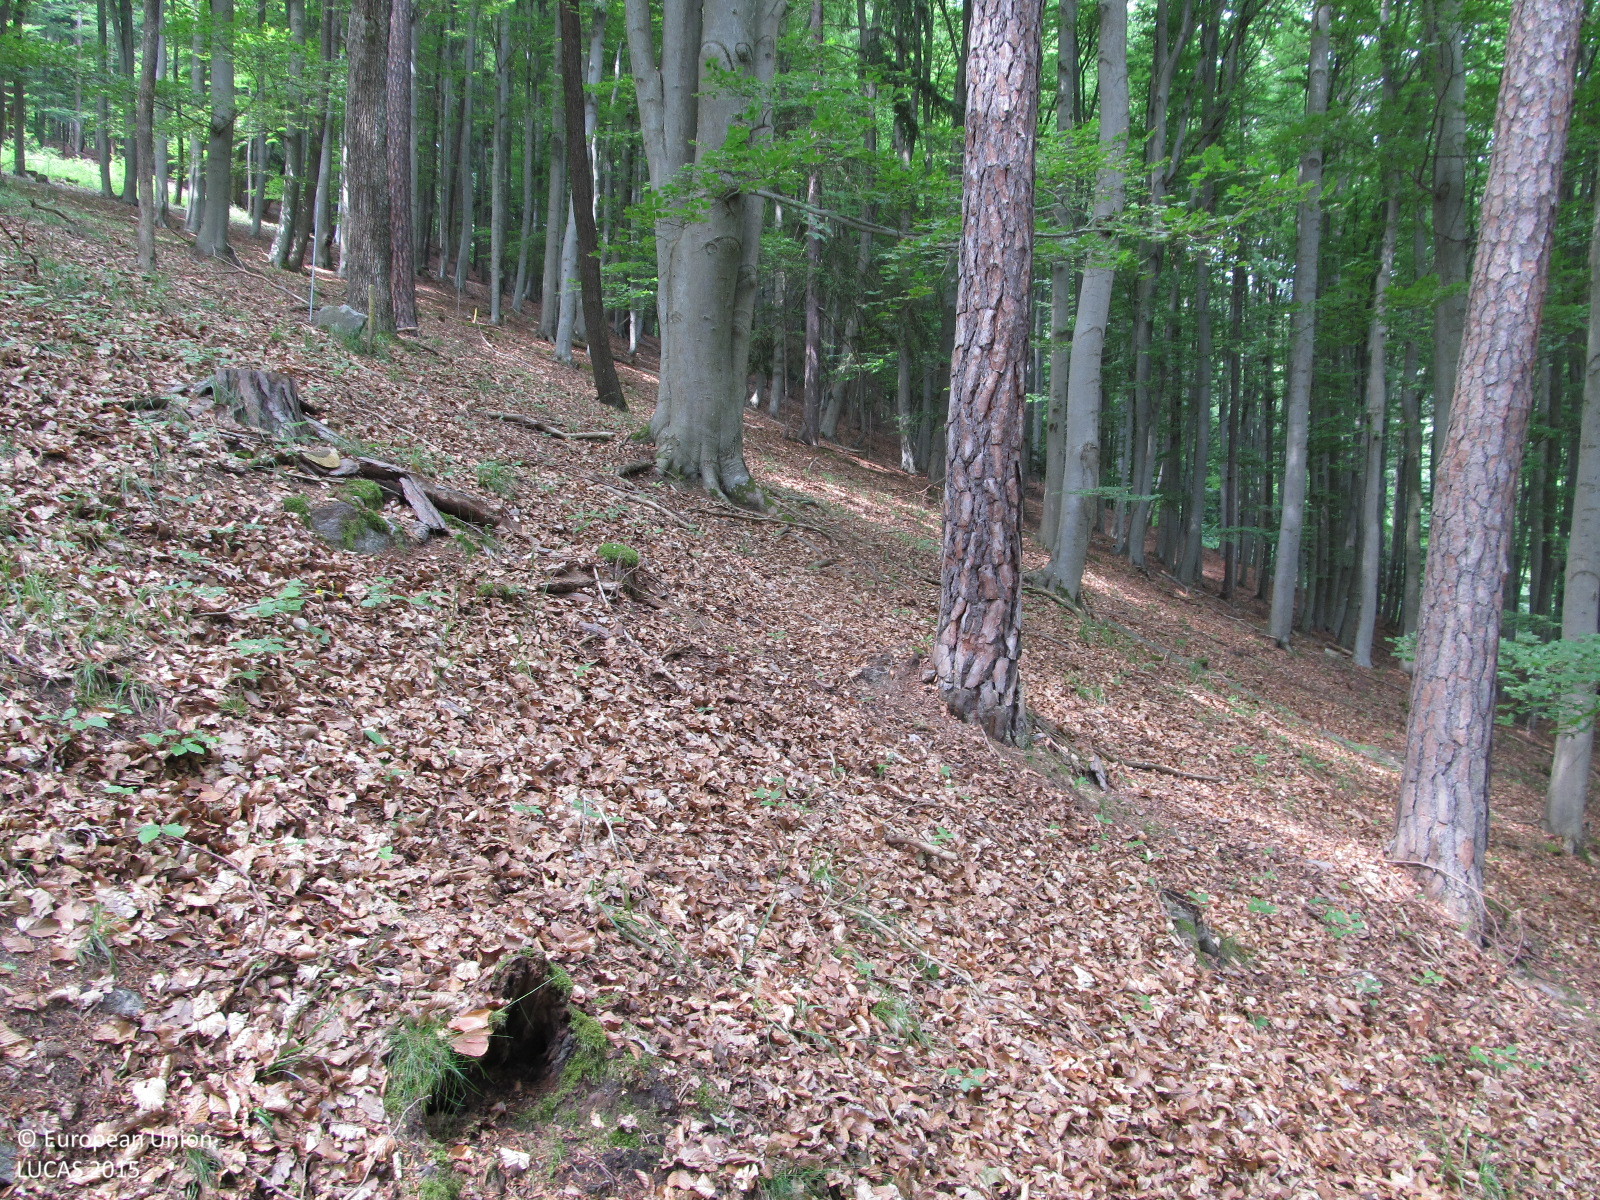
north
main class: Woodland
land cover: Broadleaved woodland
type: beech forest
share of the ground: > 75 %
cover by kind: broadleaved forest trees 60 %, coniferous forest trees 20 %, unconsolidated bare surface 20 %
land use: Forestry
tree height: > 5 m
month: June
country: AT
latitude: 48.4135
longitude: 15.4473
